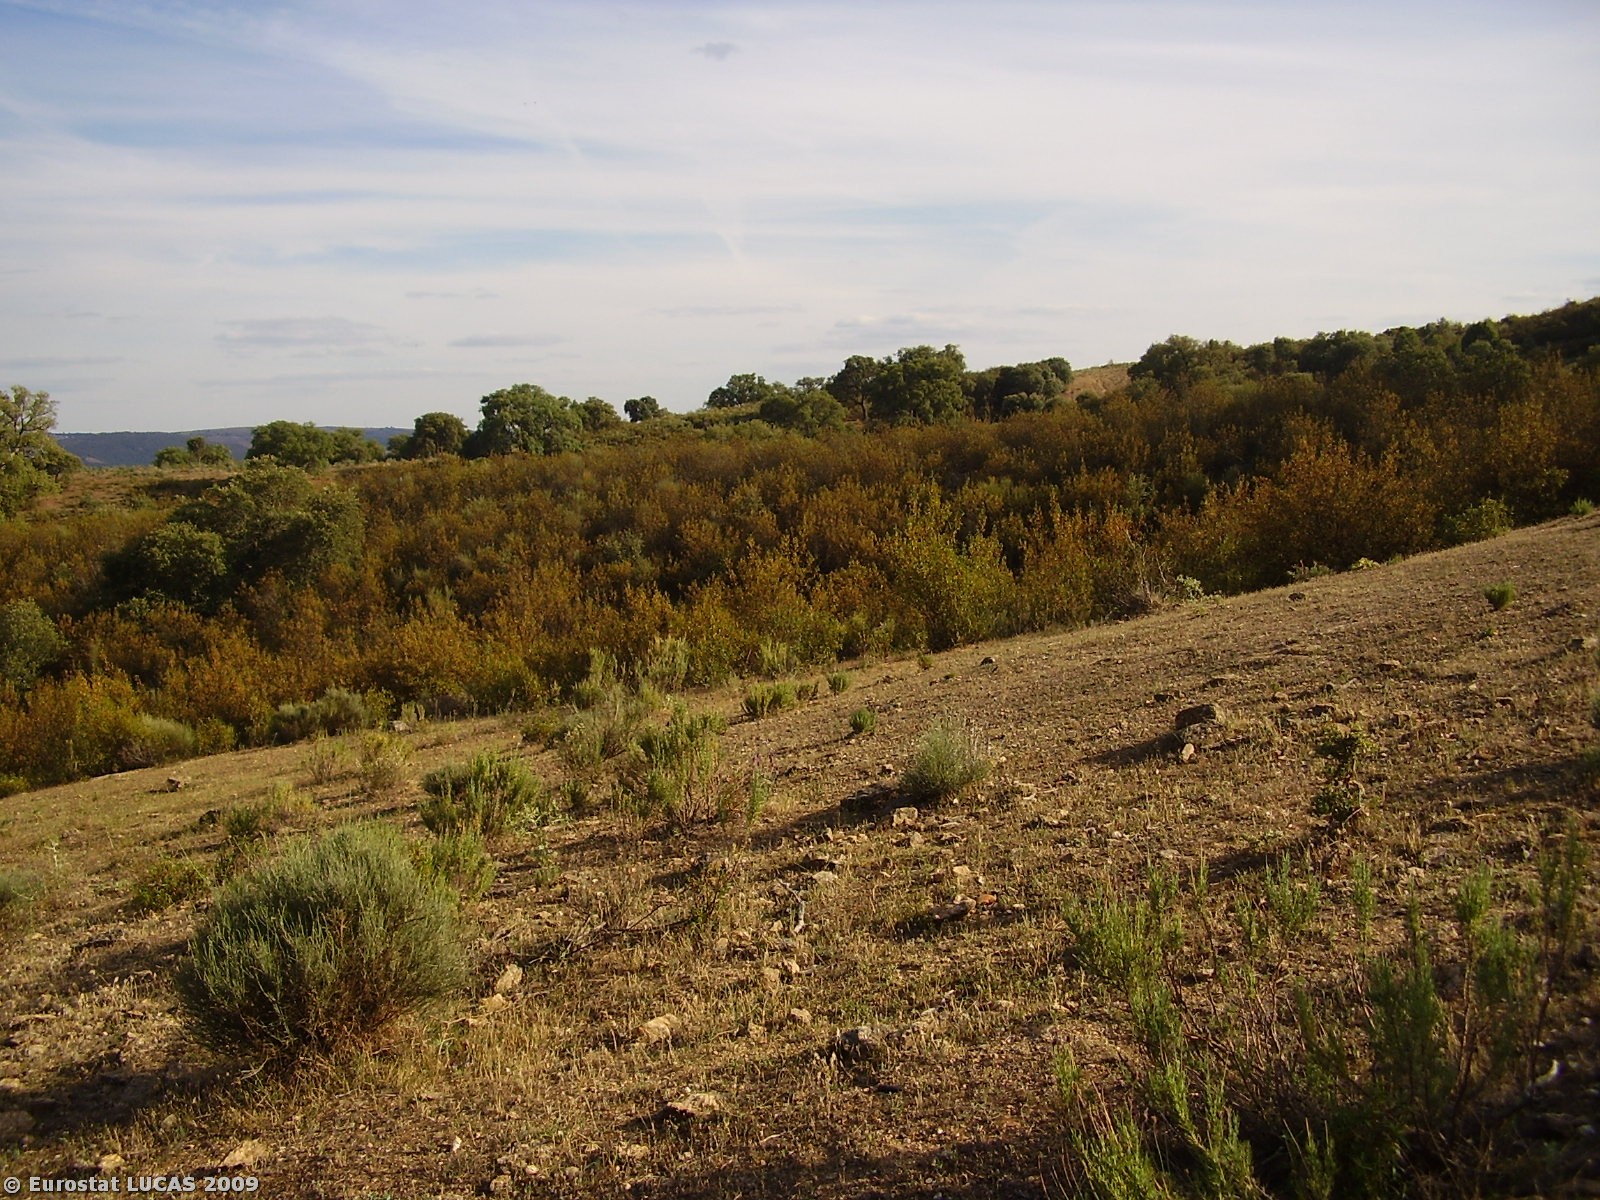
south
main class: Grassland
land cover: Grassland with sparse tree/shrub cover
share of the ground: 50 - 75 %
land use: Forestry
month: June
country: PT
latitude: 41.4797
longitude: -6.7914
